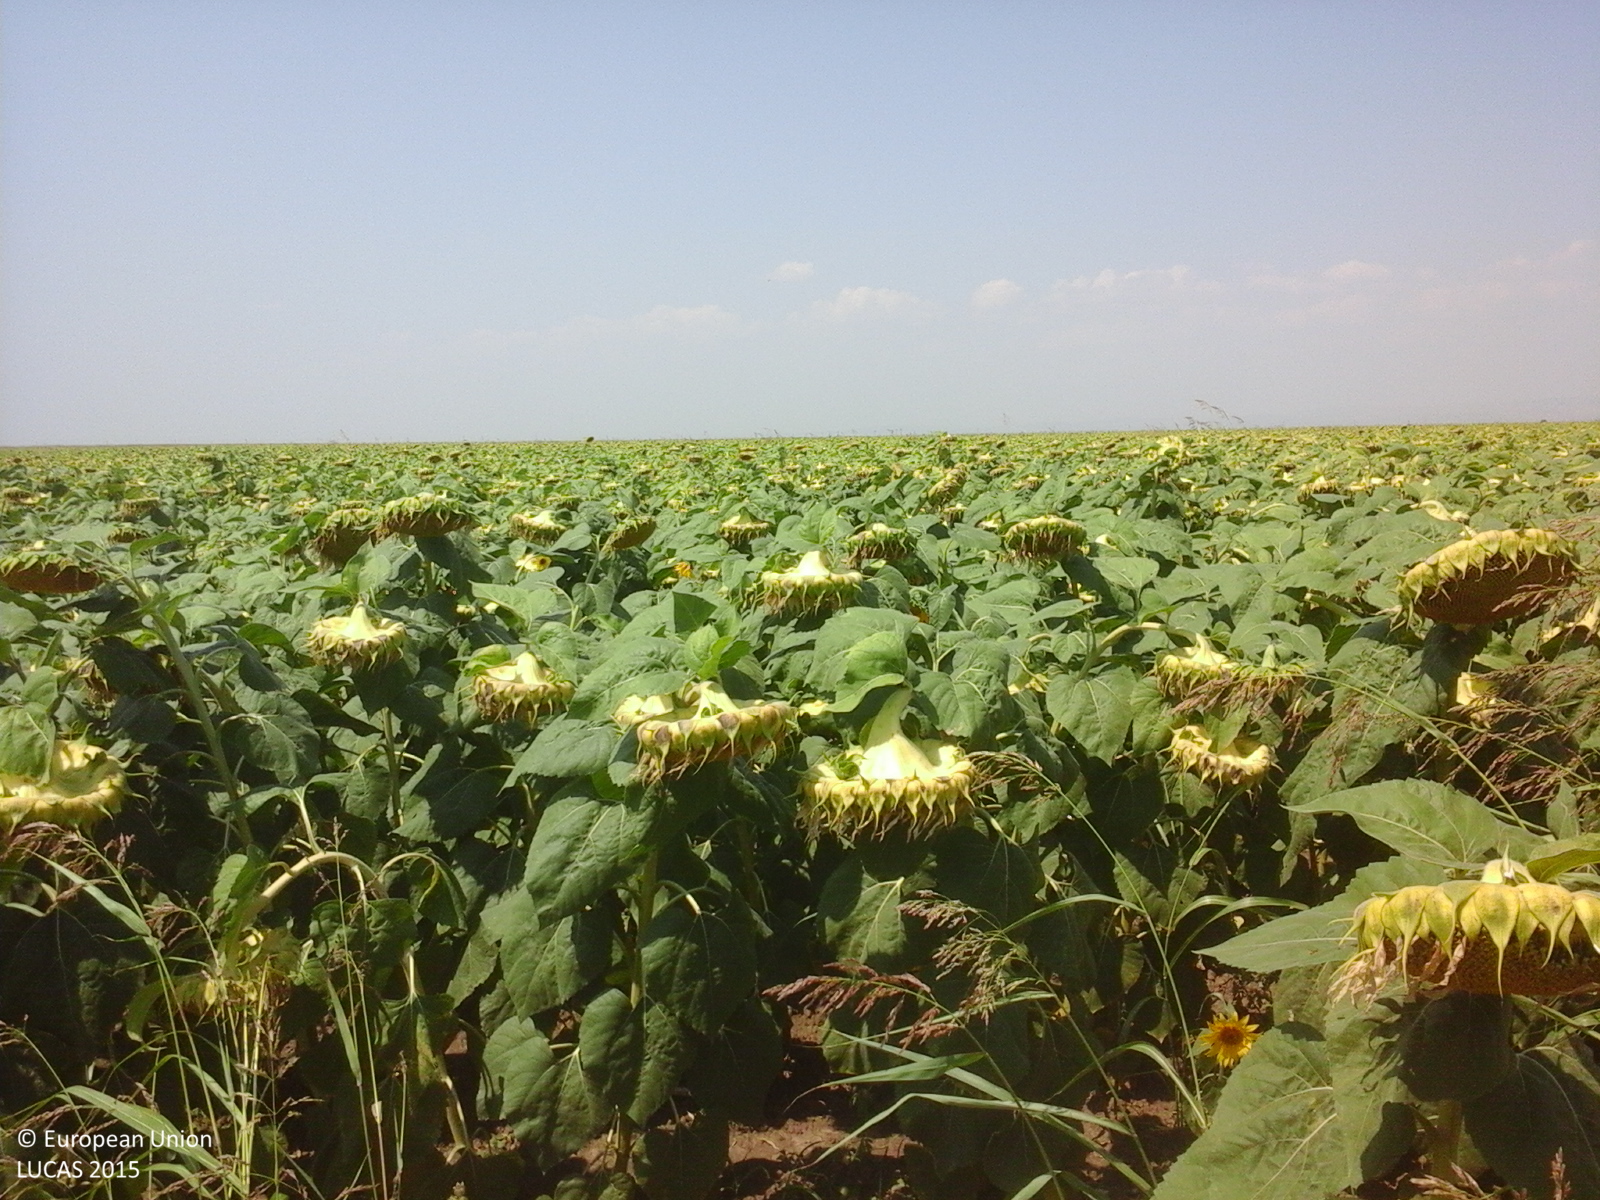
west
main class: Cropland
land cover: Sunflower
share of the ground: > 75 %
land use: Agriculture (excluding fallow land and kitchen gardens)
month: August
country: RO
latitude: 44.9325
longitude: 26.7120
